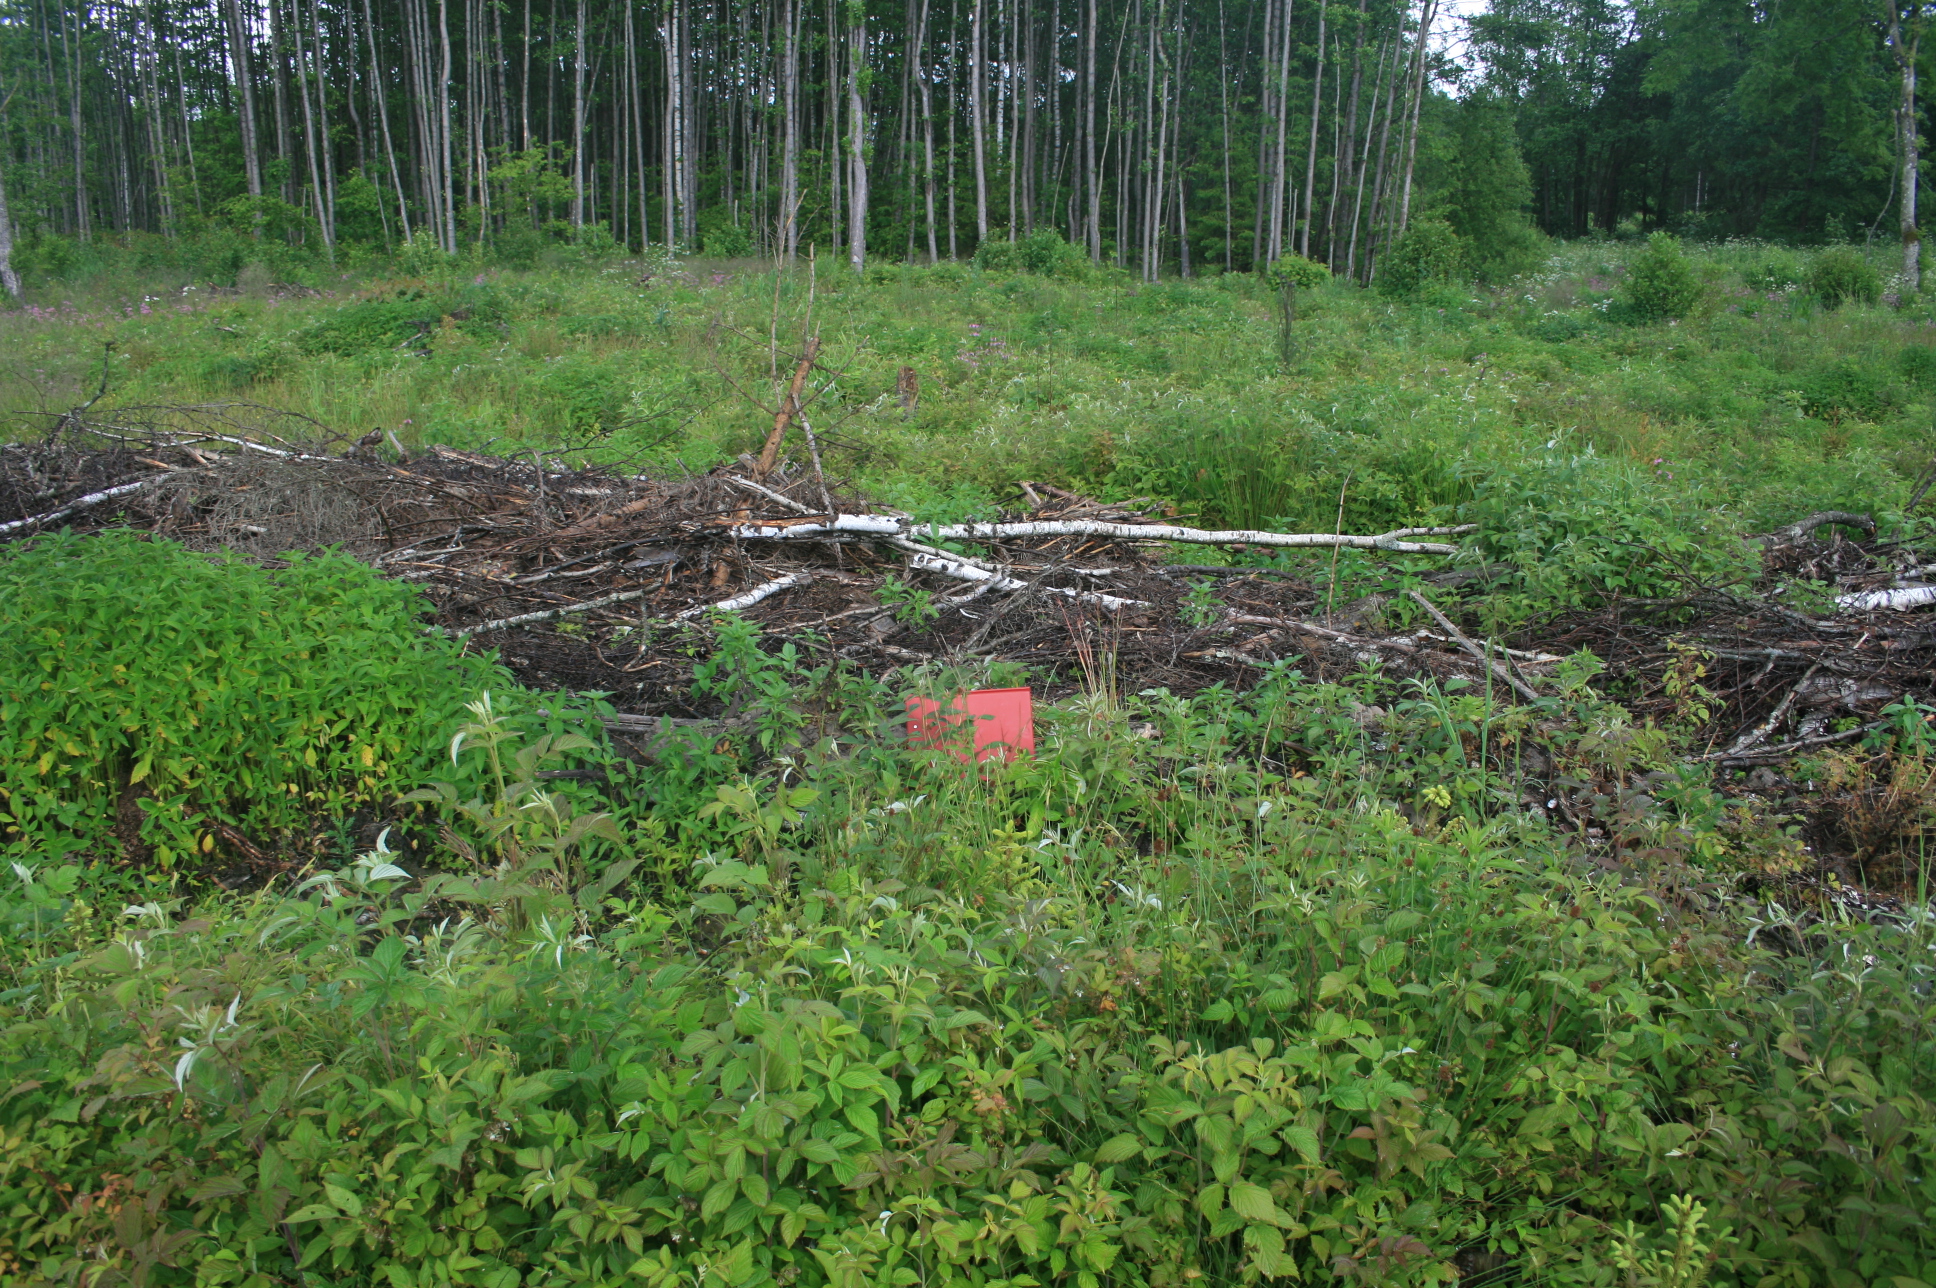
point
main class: Shrubland
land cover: Shrubland with sparse tree cover
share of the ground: > 75 %
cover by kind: shrubs 65 %, herbaceous plants 30 %, broadleaved forest trees 5 %
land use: Forestry
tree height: < 5 m
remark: Clear cut
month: June
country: LT
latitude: 55.3440
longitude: 22.0541
